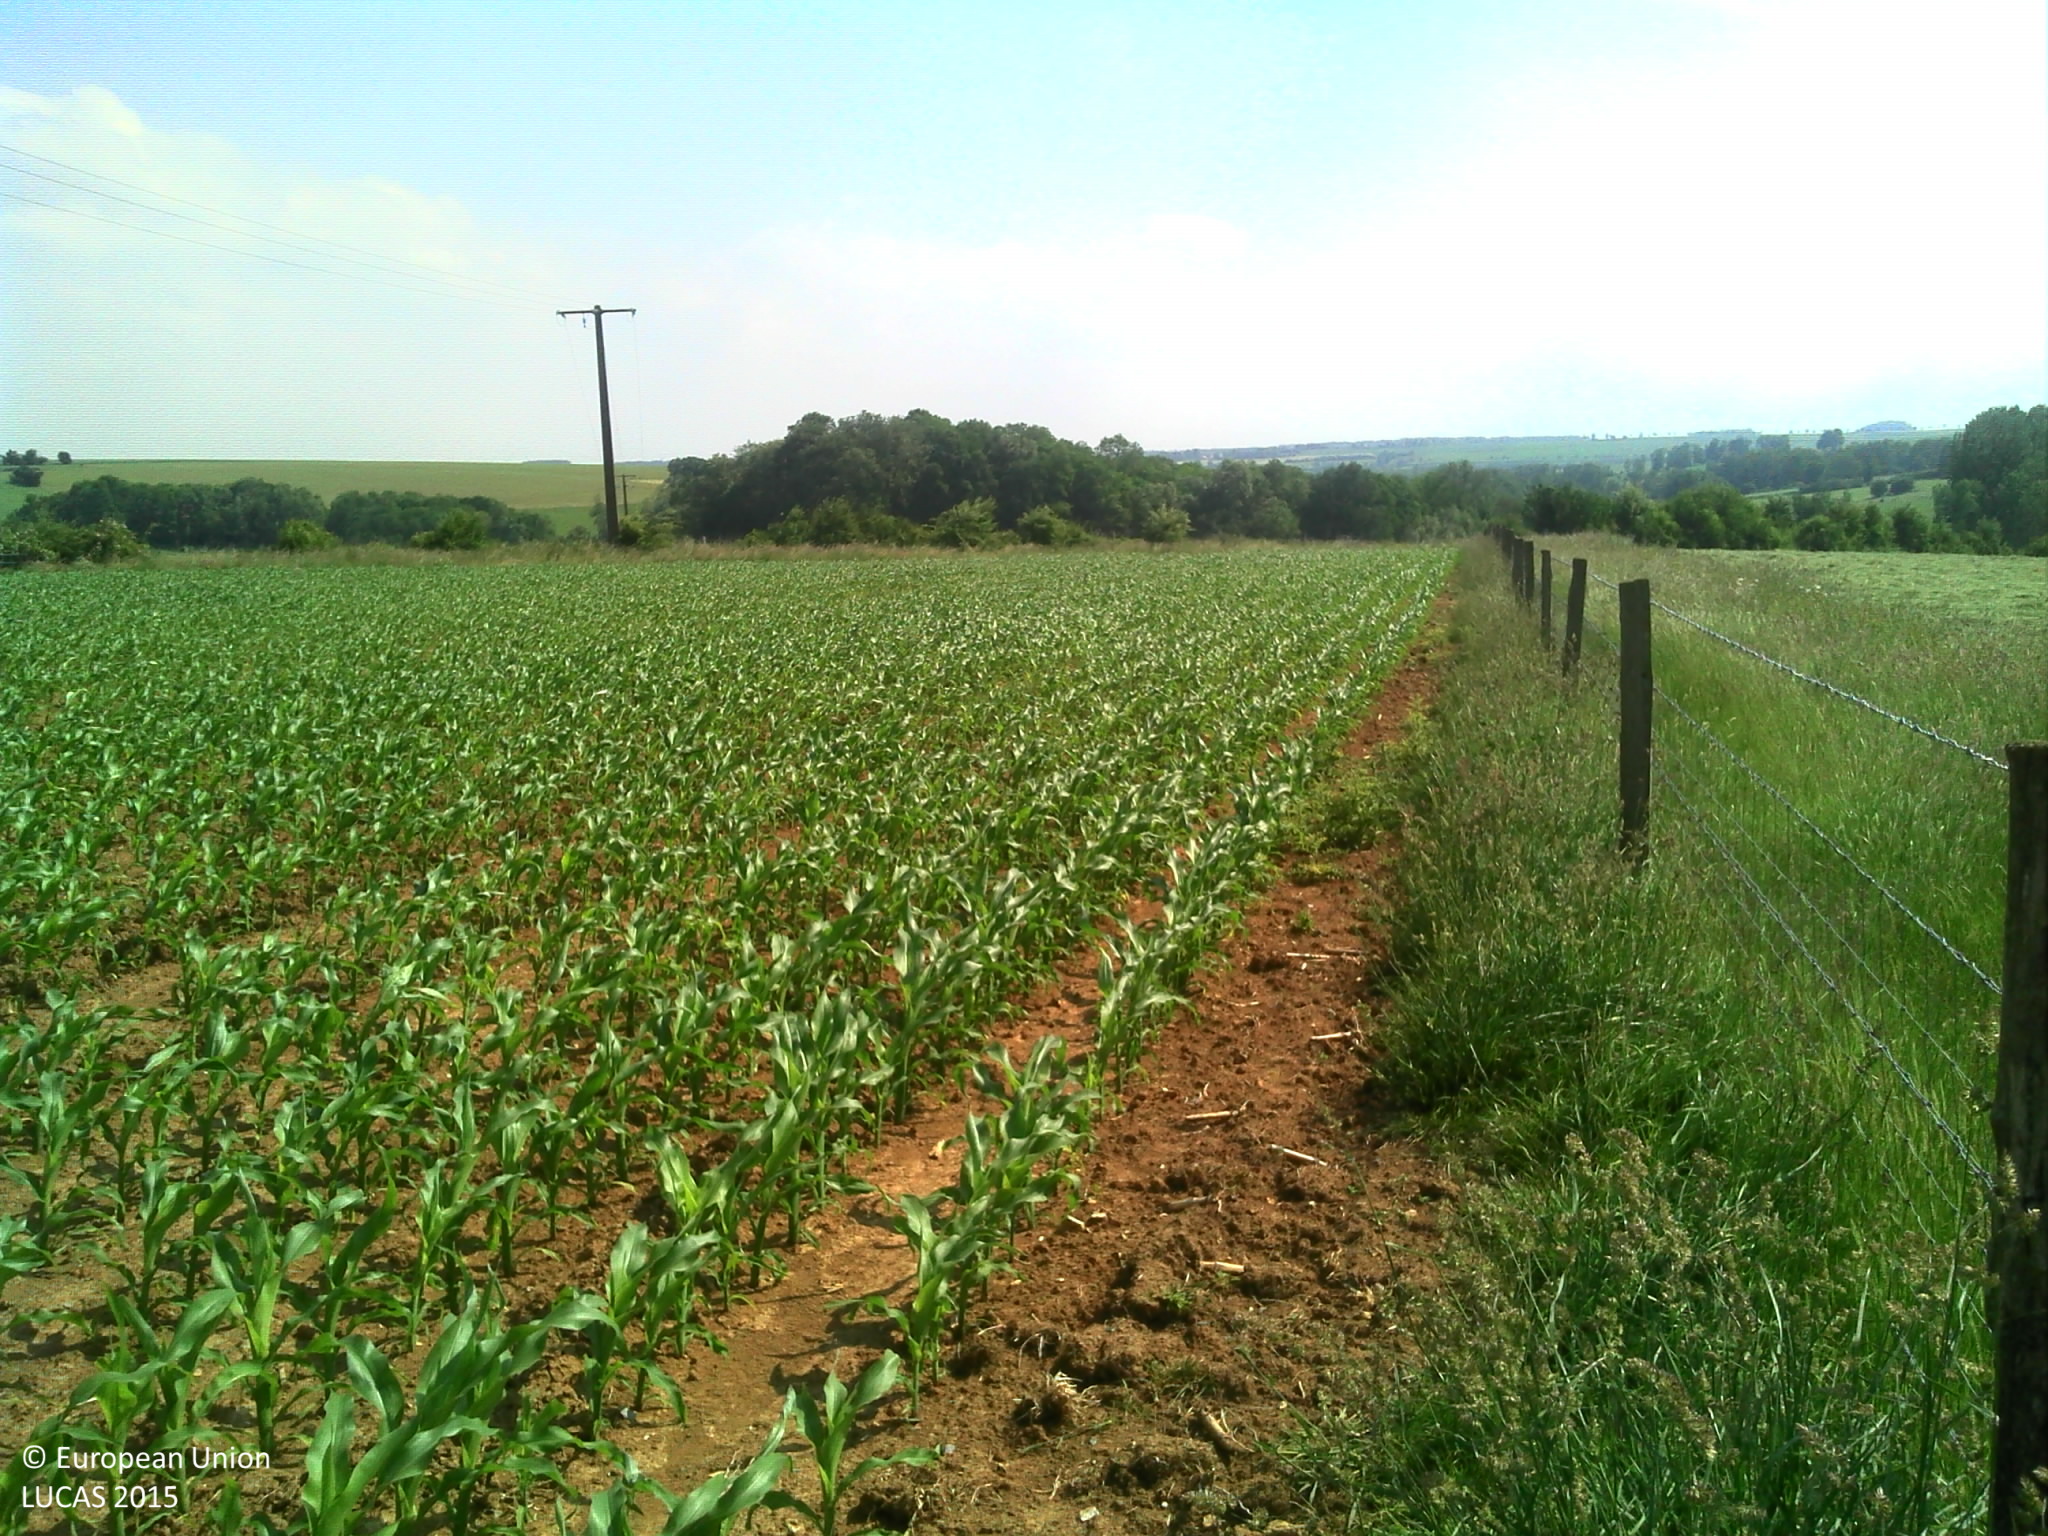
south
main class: Grassland
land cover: Grassland without tree/shrub cover
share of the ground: > 75 %
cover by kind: herbaceous plants 100 %
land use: Agriculture (excluding fallow land and kitchen gardens)
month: June
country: FR
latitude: 49.7443
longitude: 4.1248
